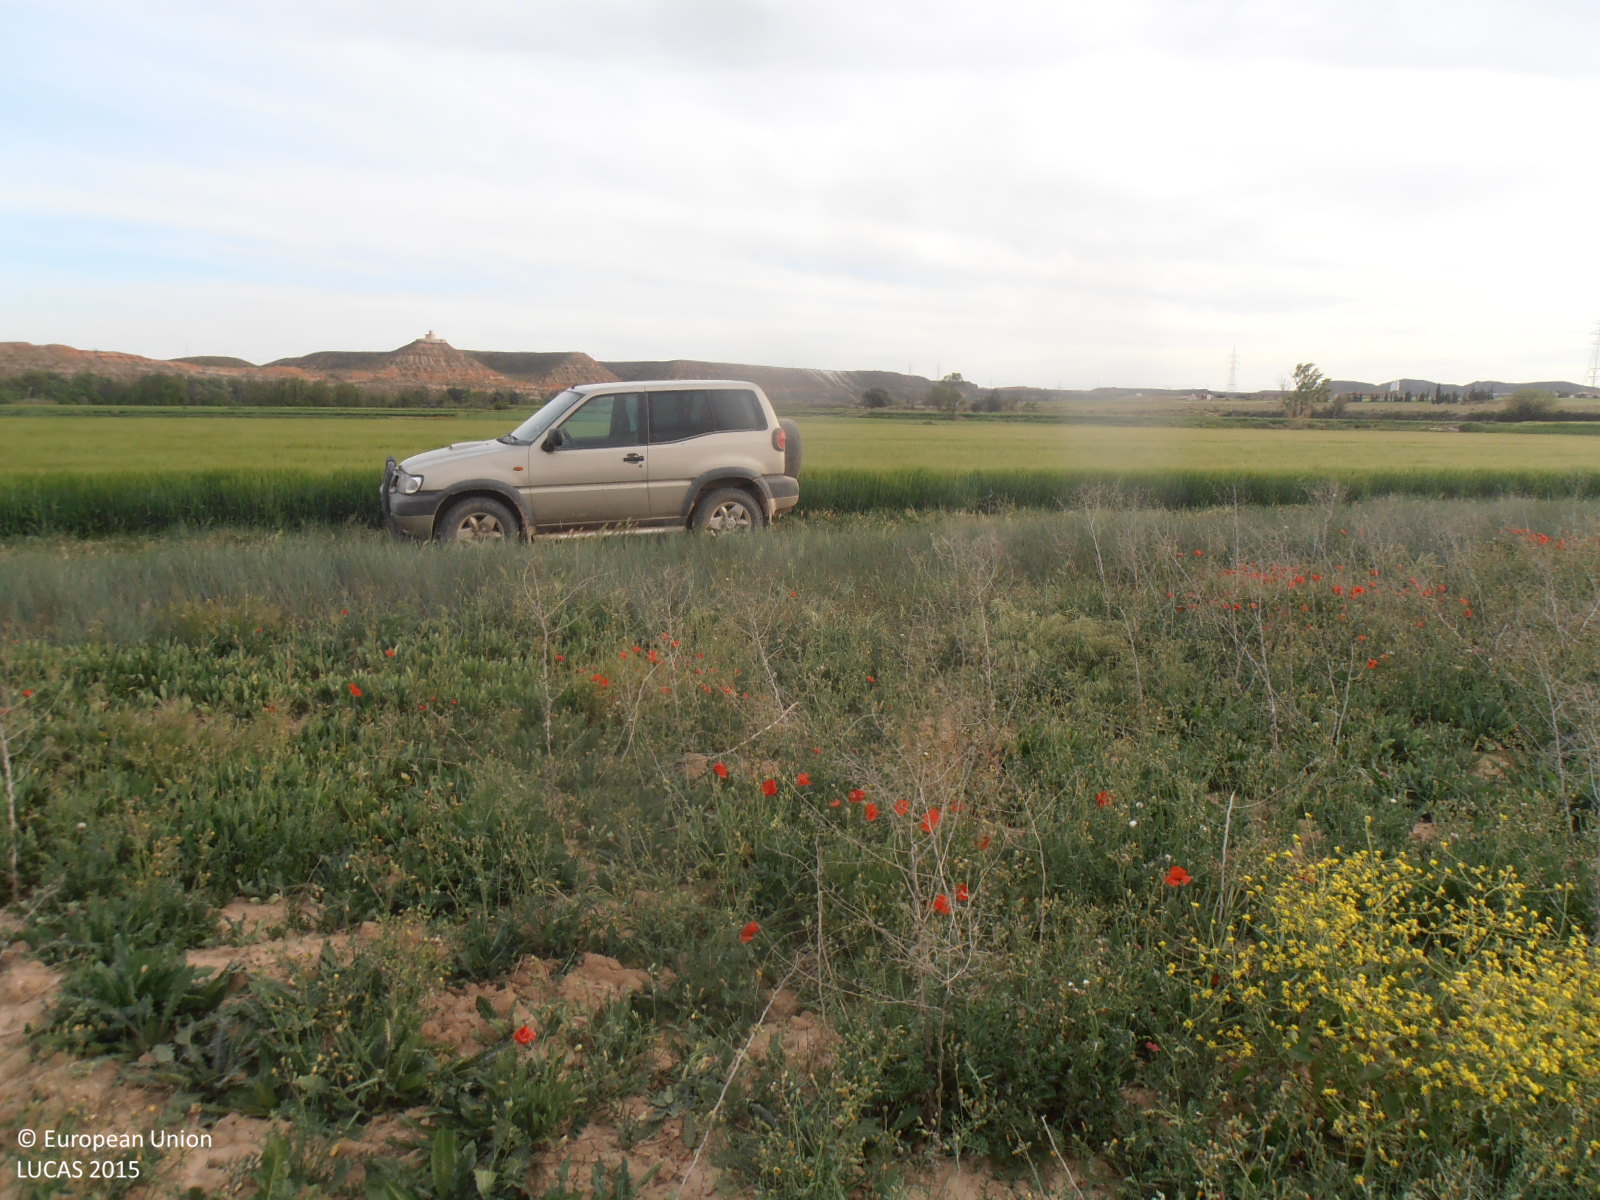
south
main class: Grassland
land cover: Spontaneously vegetated surfaces
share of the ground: > 75 %
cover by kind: herbaceous plants 100 %
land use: Fallow land
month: April
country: ES
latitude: 41.3371
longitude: -0.3757
